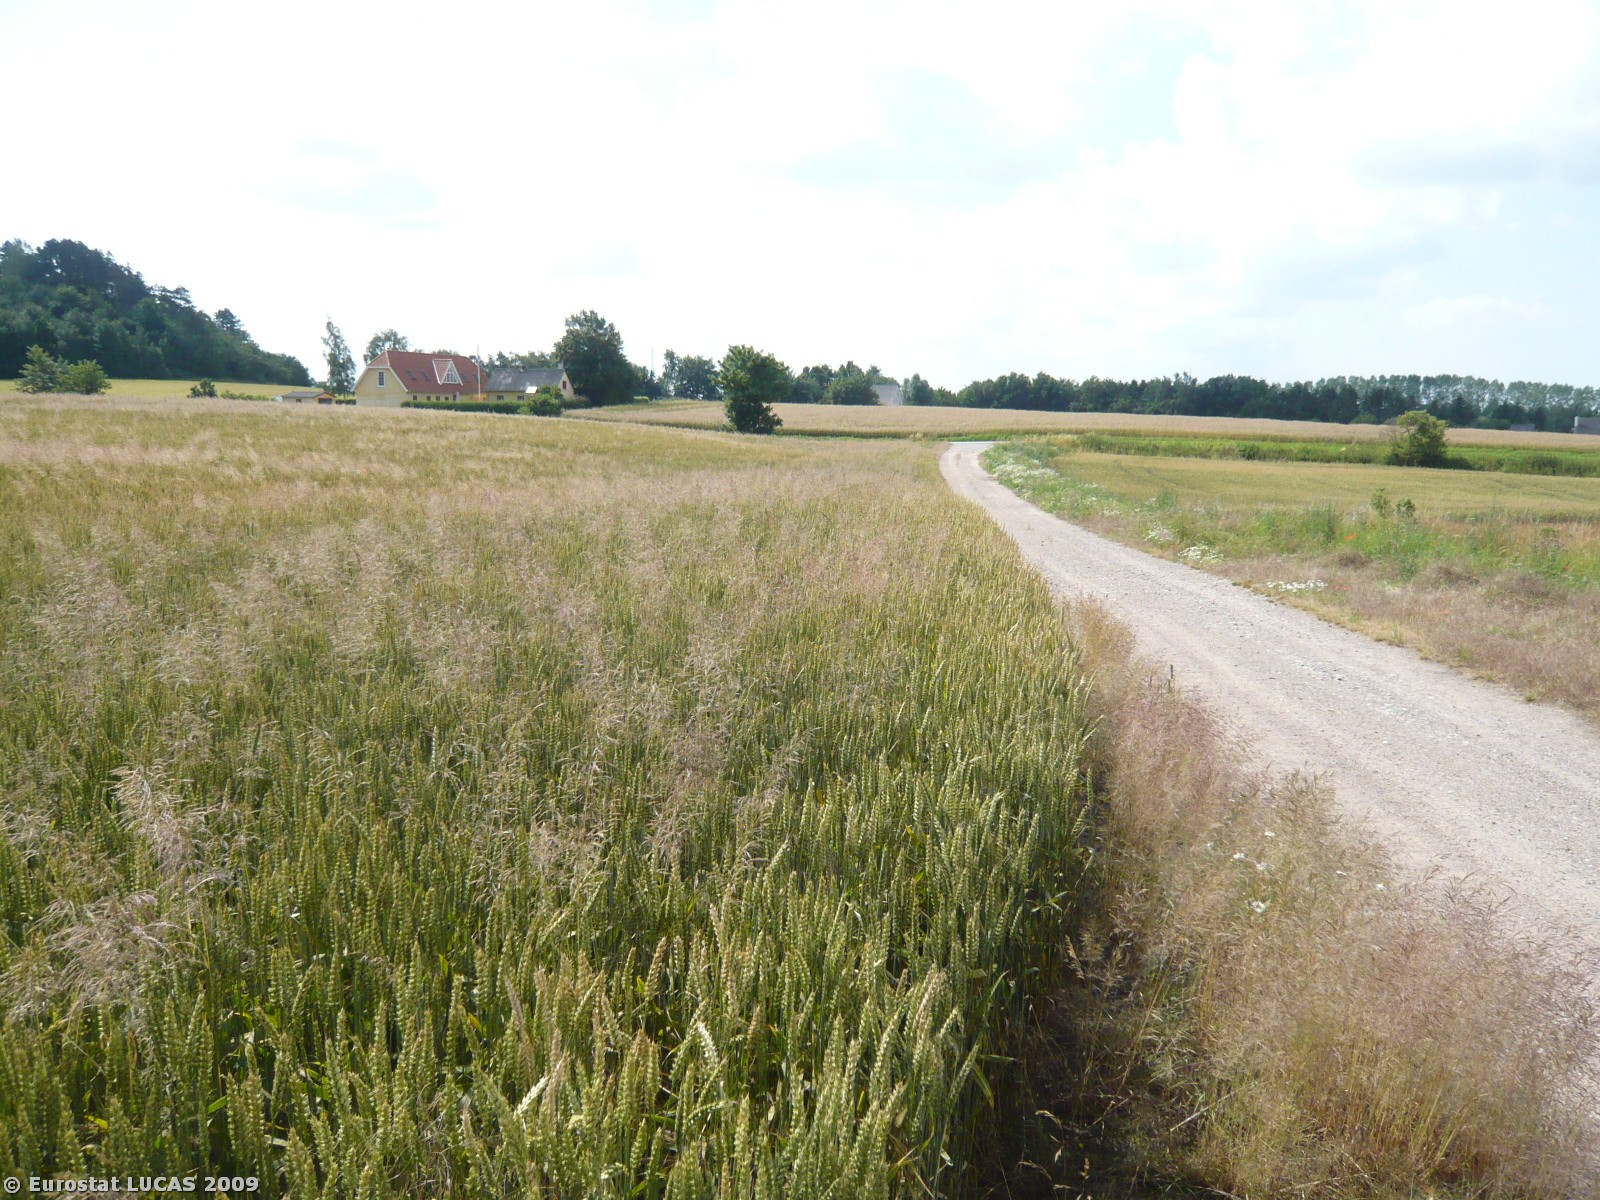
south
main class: Woodland
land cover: Broadleaved woodland
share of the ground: > 75 %
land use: Unused
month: July
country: DK
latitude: 55.8013
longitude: 11.5140
